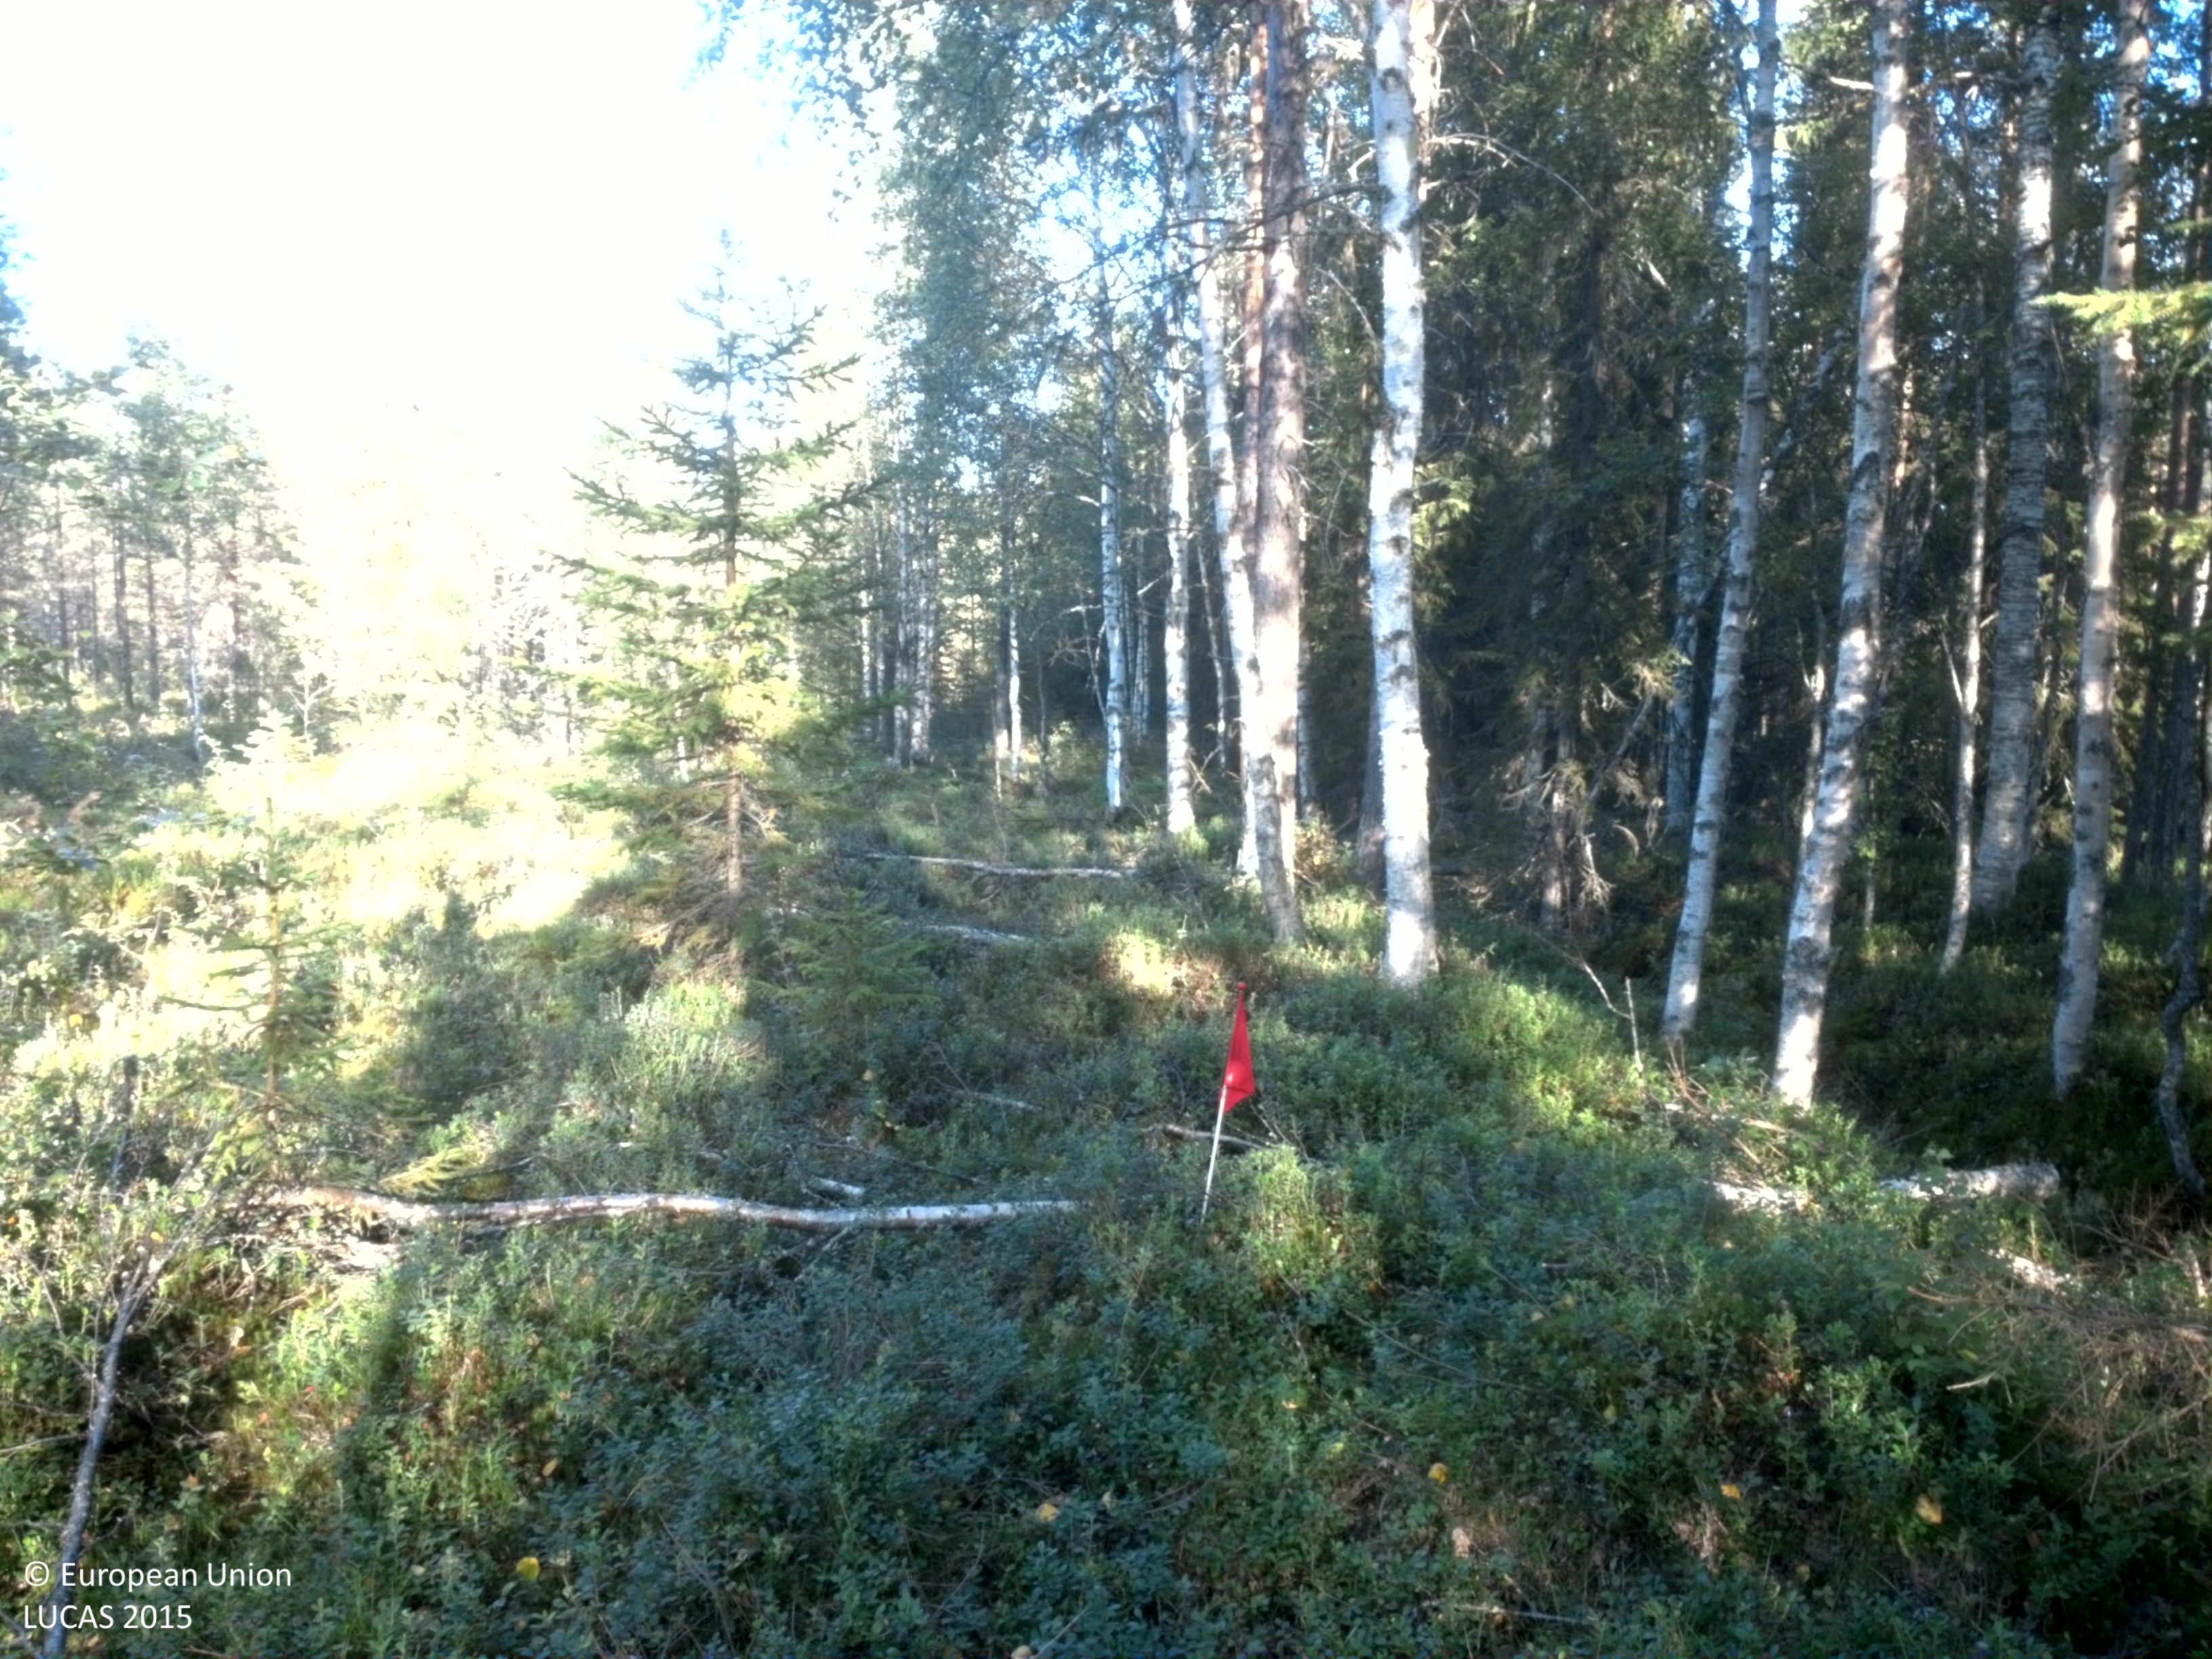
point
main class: Woodland
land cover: Pine dominated mixed woodland
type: boreal forest
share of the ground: 50 - 75 %
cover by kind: coniferous forest trees 45 %, shrubs 35 %, broadleaved forest trees 15 %, lichens and mosses 5 %
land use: Forestry
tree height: > 5 m
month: August
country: SE
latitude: 64.6165
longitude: 18.3092
